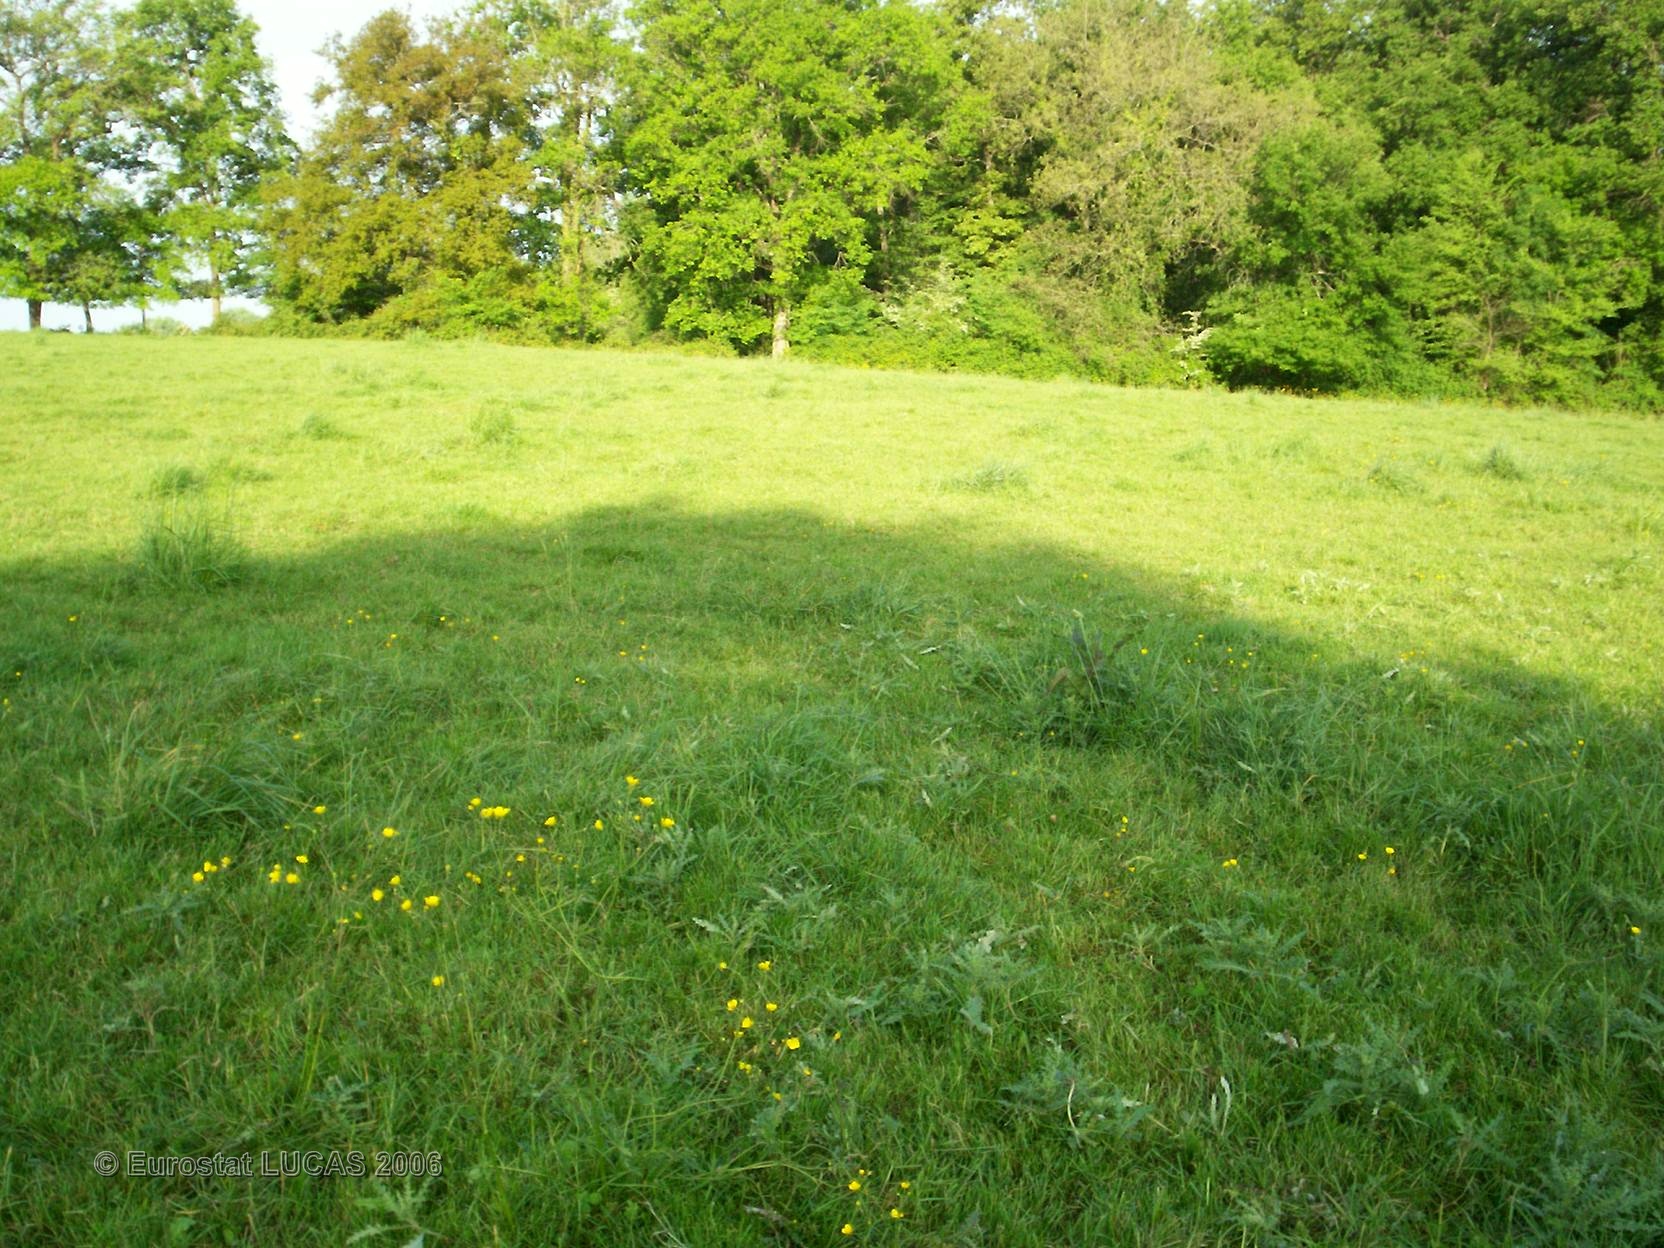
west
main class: Grassland
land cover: Grassland without tree/shrub cover
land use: Agriculture (excluding fallow land and kitchen gardens)
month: May
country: FR
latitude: 43.7938
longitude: 0.1885
